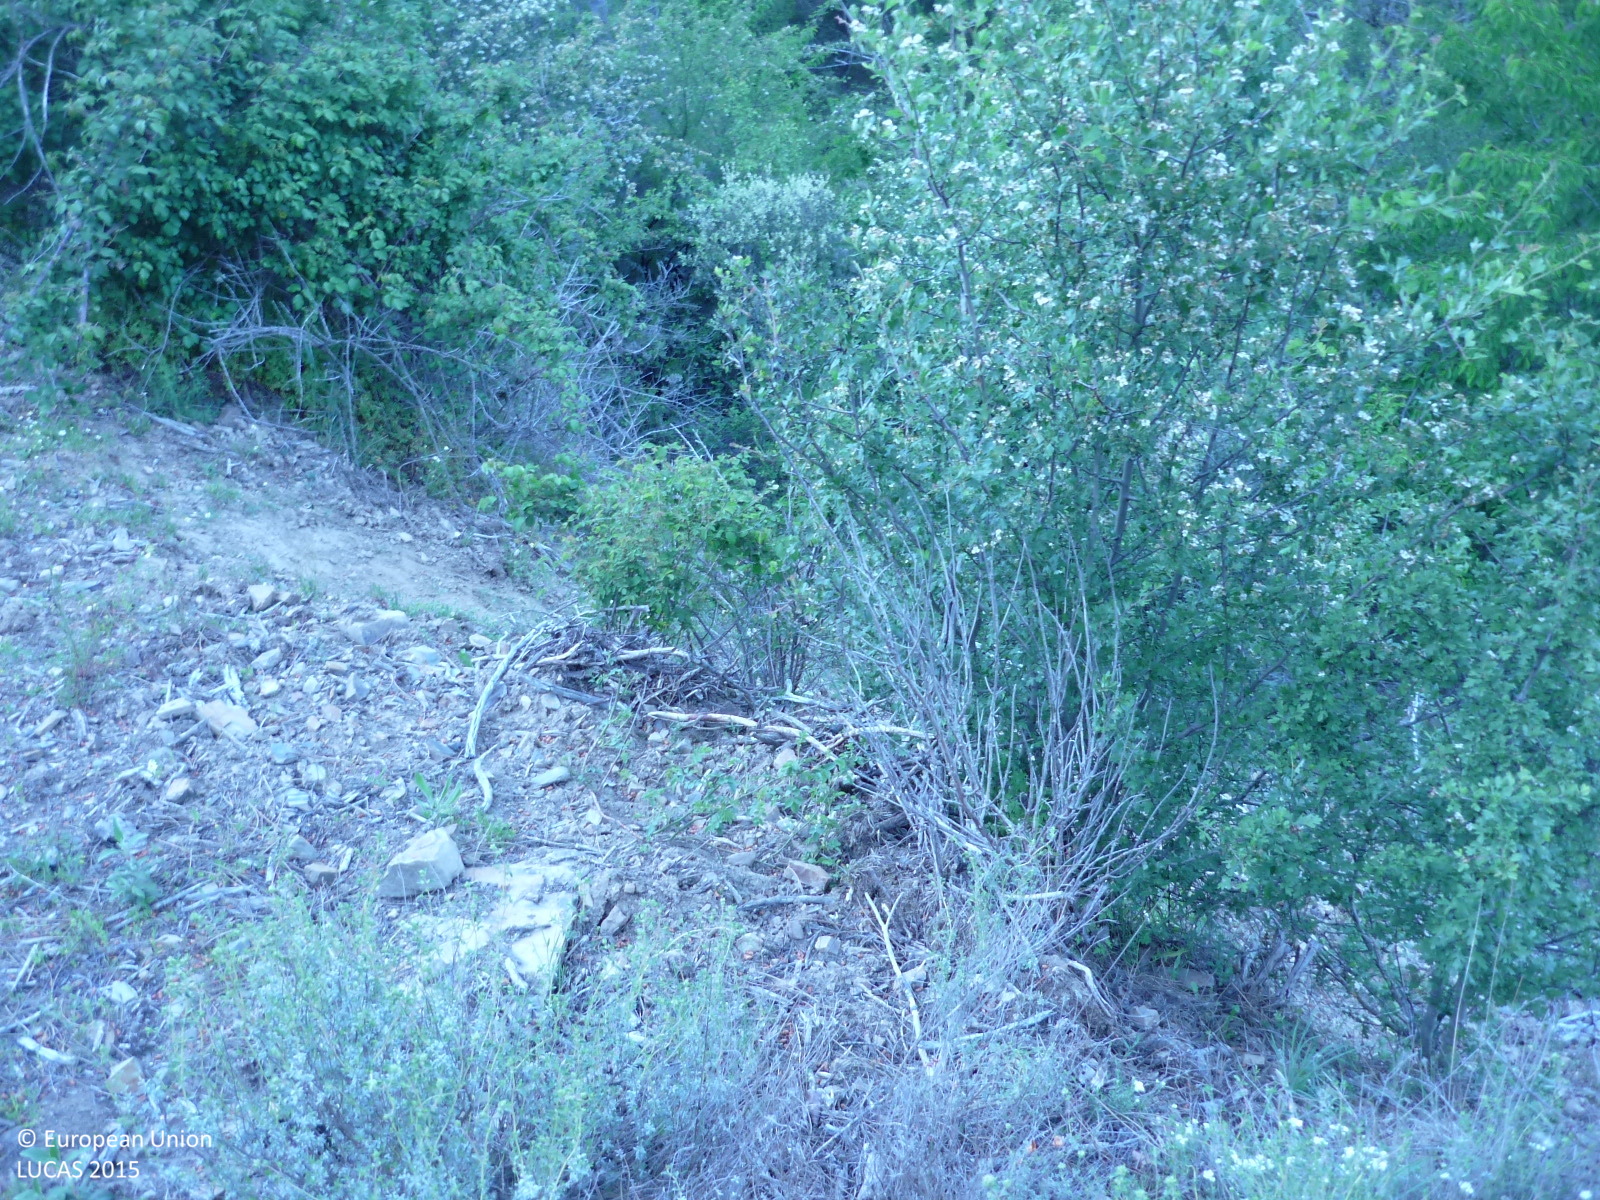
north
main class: Woodland
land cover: Broadleaved woodland
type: thermophilous deciduous forest
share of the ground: > 75 %
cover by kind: broadleaved forest trees 80 %, shrubs 10 %, herbaceous plants 10 %
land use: Semi-natural and natural areas not in use
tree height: < 5 m
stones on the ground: < 10 %
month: May
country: ES
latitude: 41.0311
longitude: -3.3741
